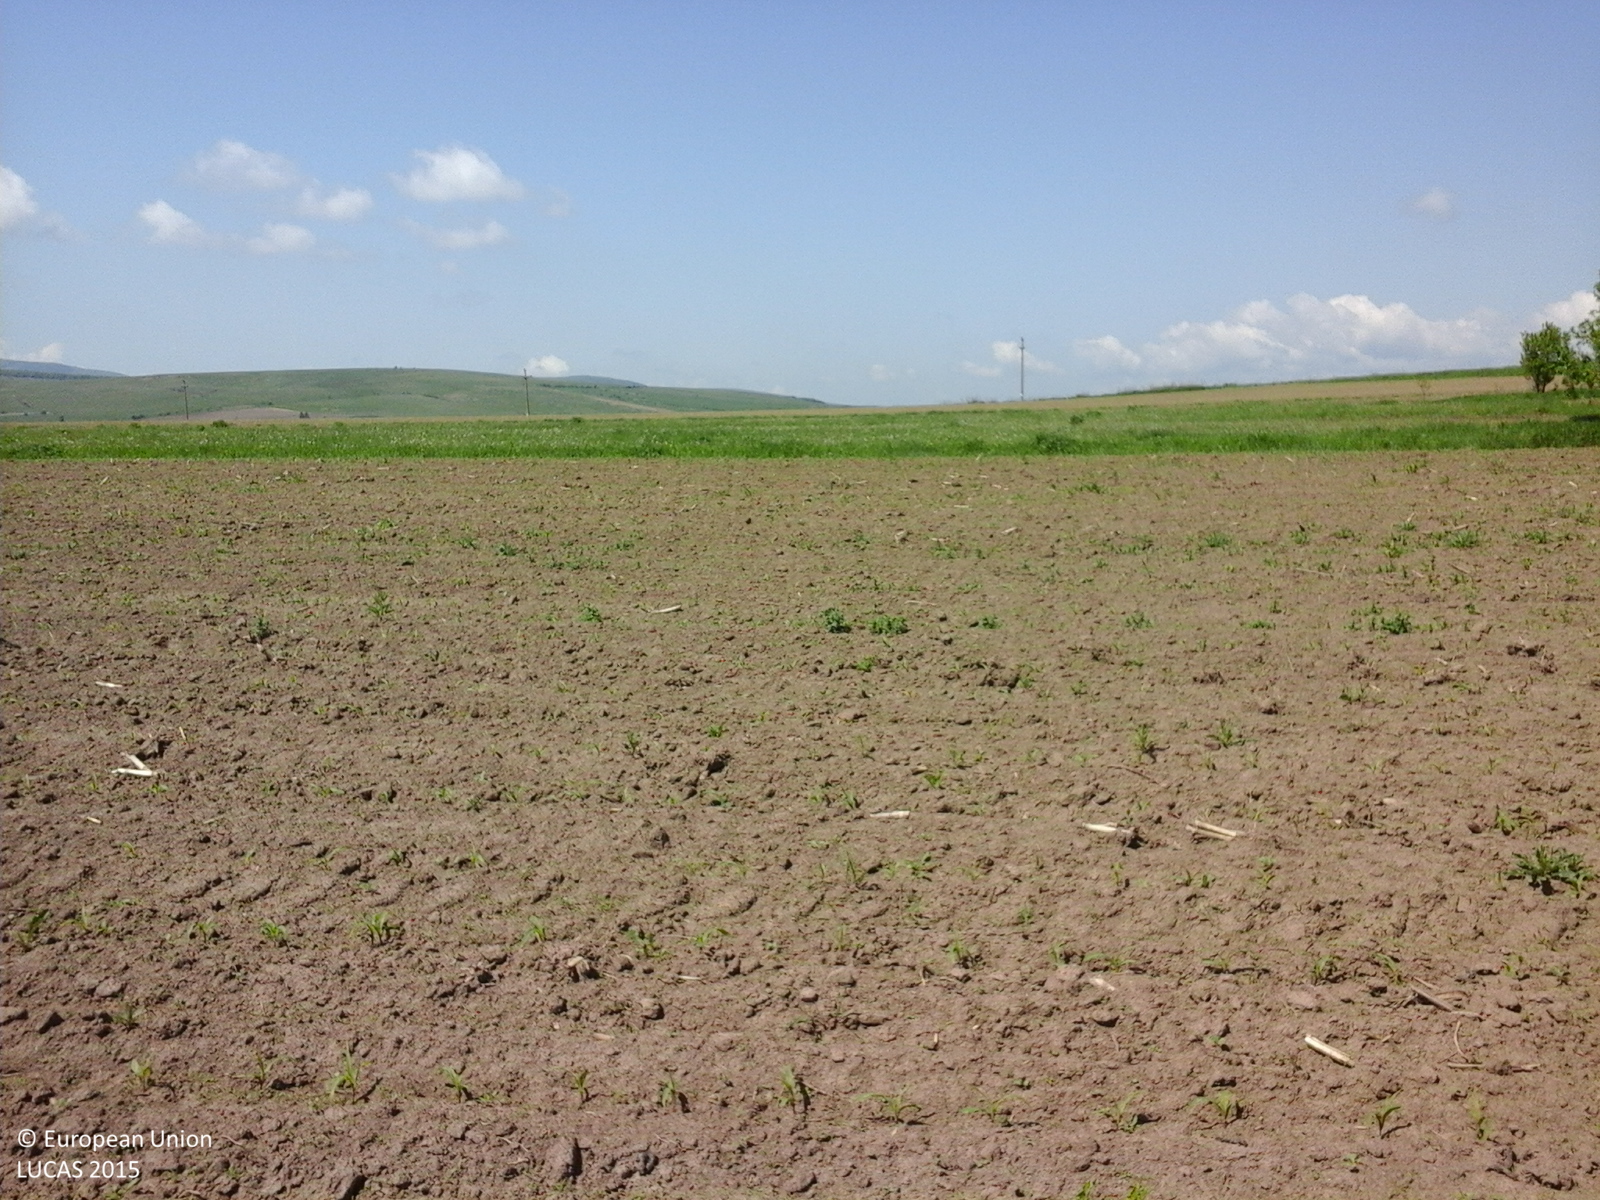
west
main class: Cropland
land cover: Maize
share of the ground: < 10 %
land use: Agriculture (excluding fallow land and kitchen gardens)
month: May
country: RO
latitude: 45.8143
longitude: 26.0095
